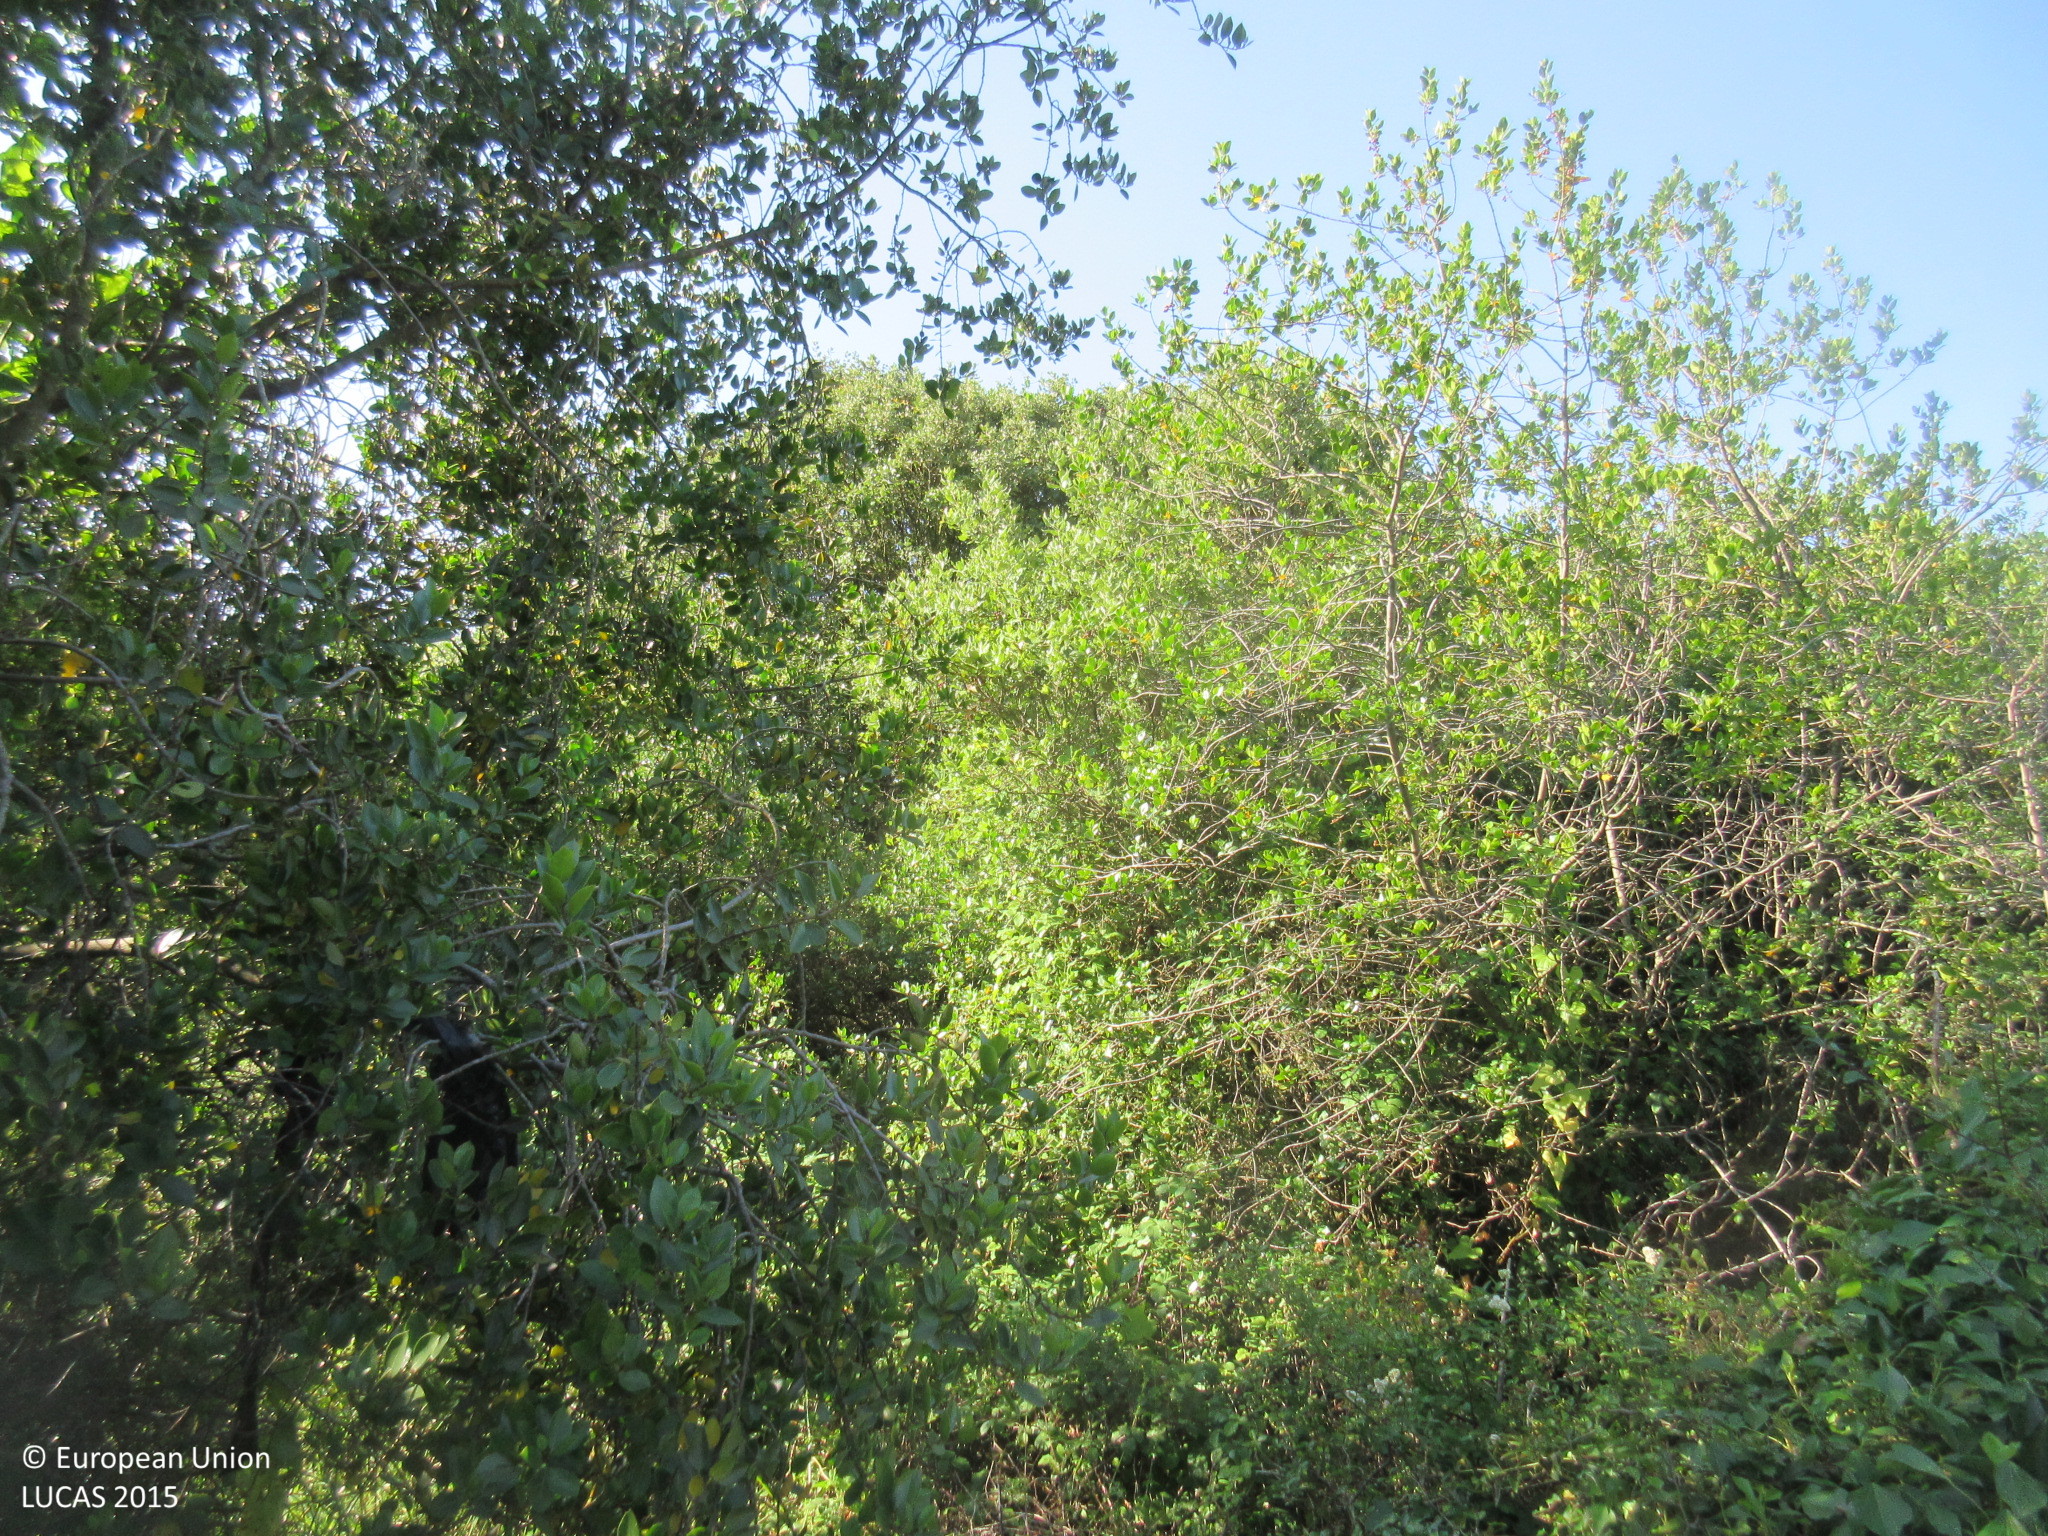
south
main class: Woodland
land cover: Broadleaved woodland
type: broadleaved evergreen forest
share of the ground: > 75 %
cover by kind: broadleaved forest trees 90 %, shrubs 10 %
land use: Semi-natural and natural areas not in use
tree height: > 5 m
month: June
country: ES
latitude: 43.4099
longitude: -6.0099
